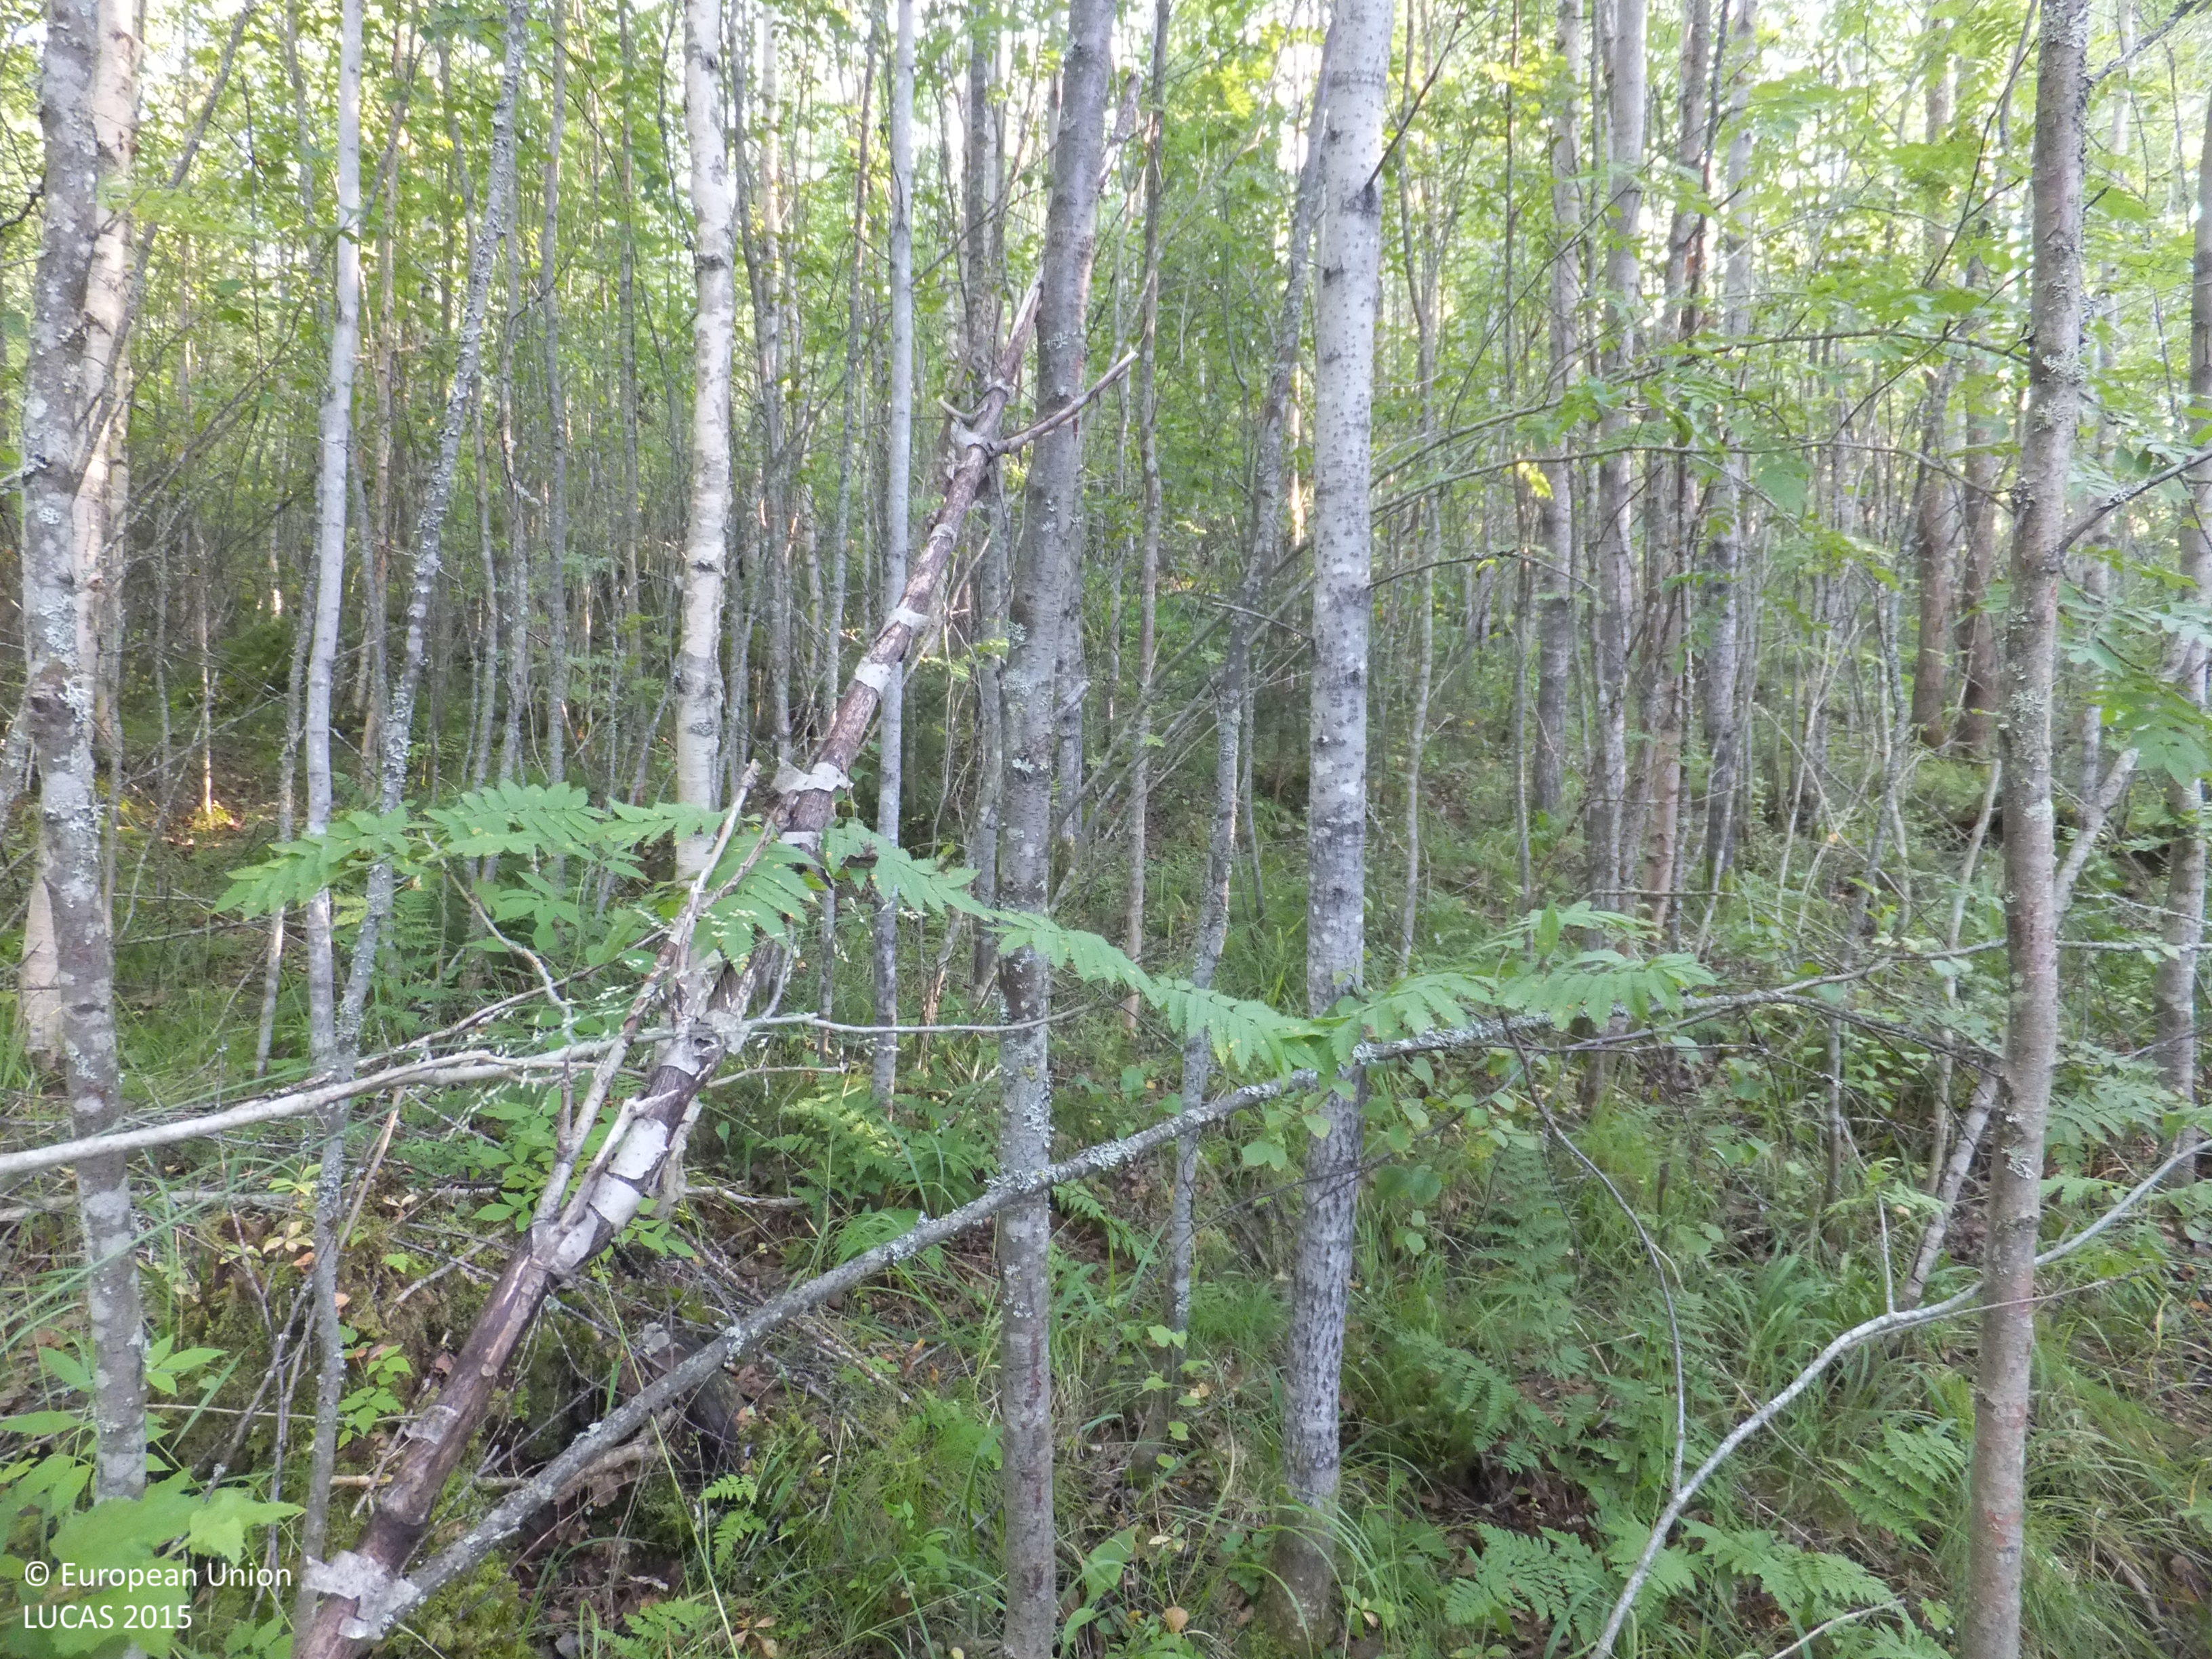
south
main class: Woodland
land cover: Broadleaved woodland
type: boreal forest
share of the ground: > 75 %
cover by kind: broadleaved forest trees 85 %, herbaceous plants 10 %, lichens and mosses 5 %
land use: Forestry
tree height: > 5 m
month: August
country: FI
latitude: 63.1142
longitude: 22.7193
